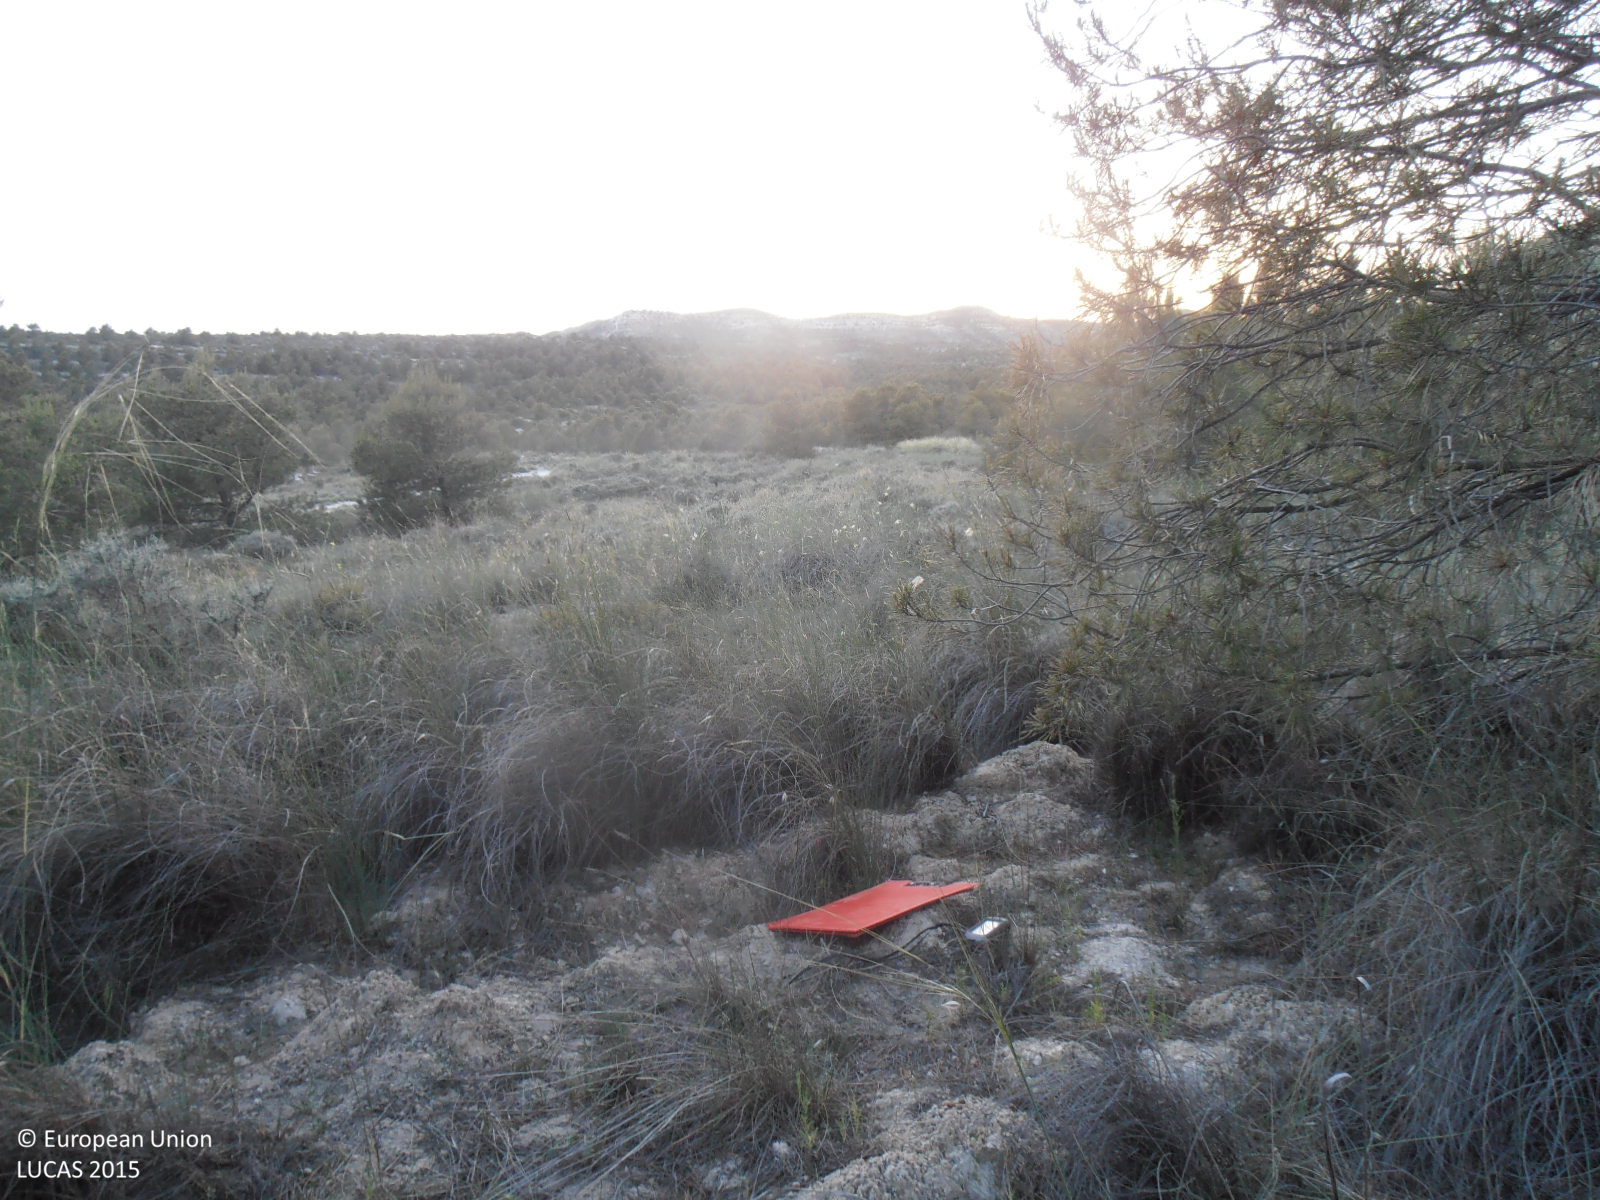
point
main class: Woodland
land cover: Pine dominated coniferous woodland
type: coniferous forest of the mediterranean region
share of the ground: 25 - 50 %
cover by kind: coniferous forest trees 45 %, shrubs 30 %, consolidated bare surface 25 %
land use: Forestry
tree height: < 5 m
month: May
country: ES
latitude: 41.5772
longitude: -1.0204
